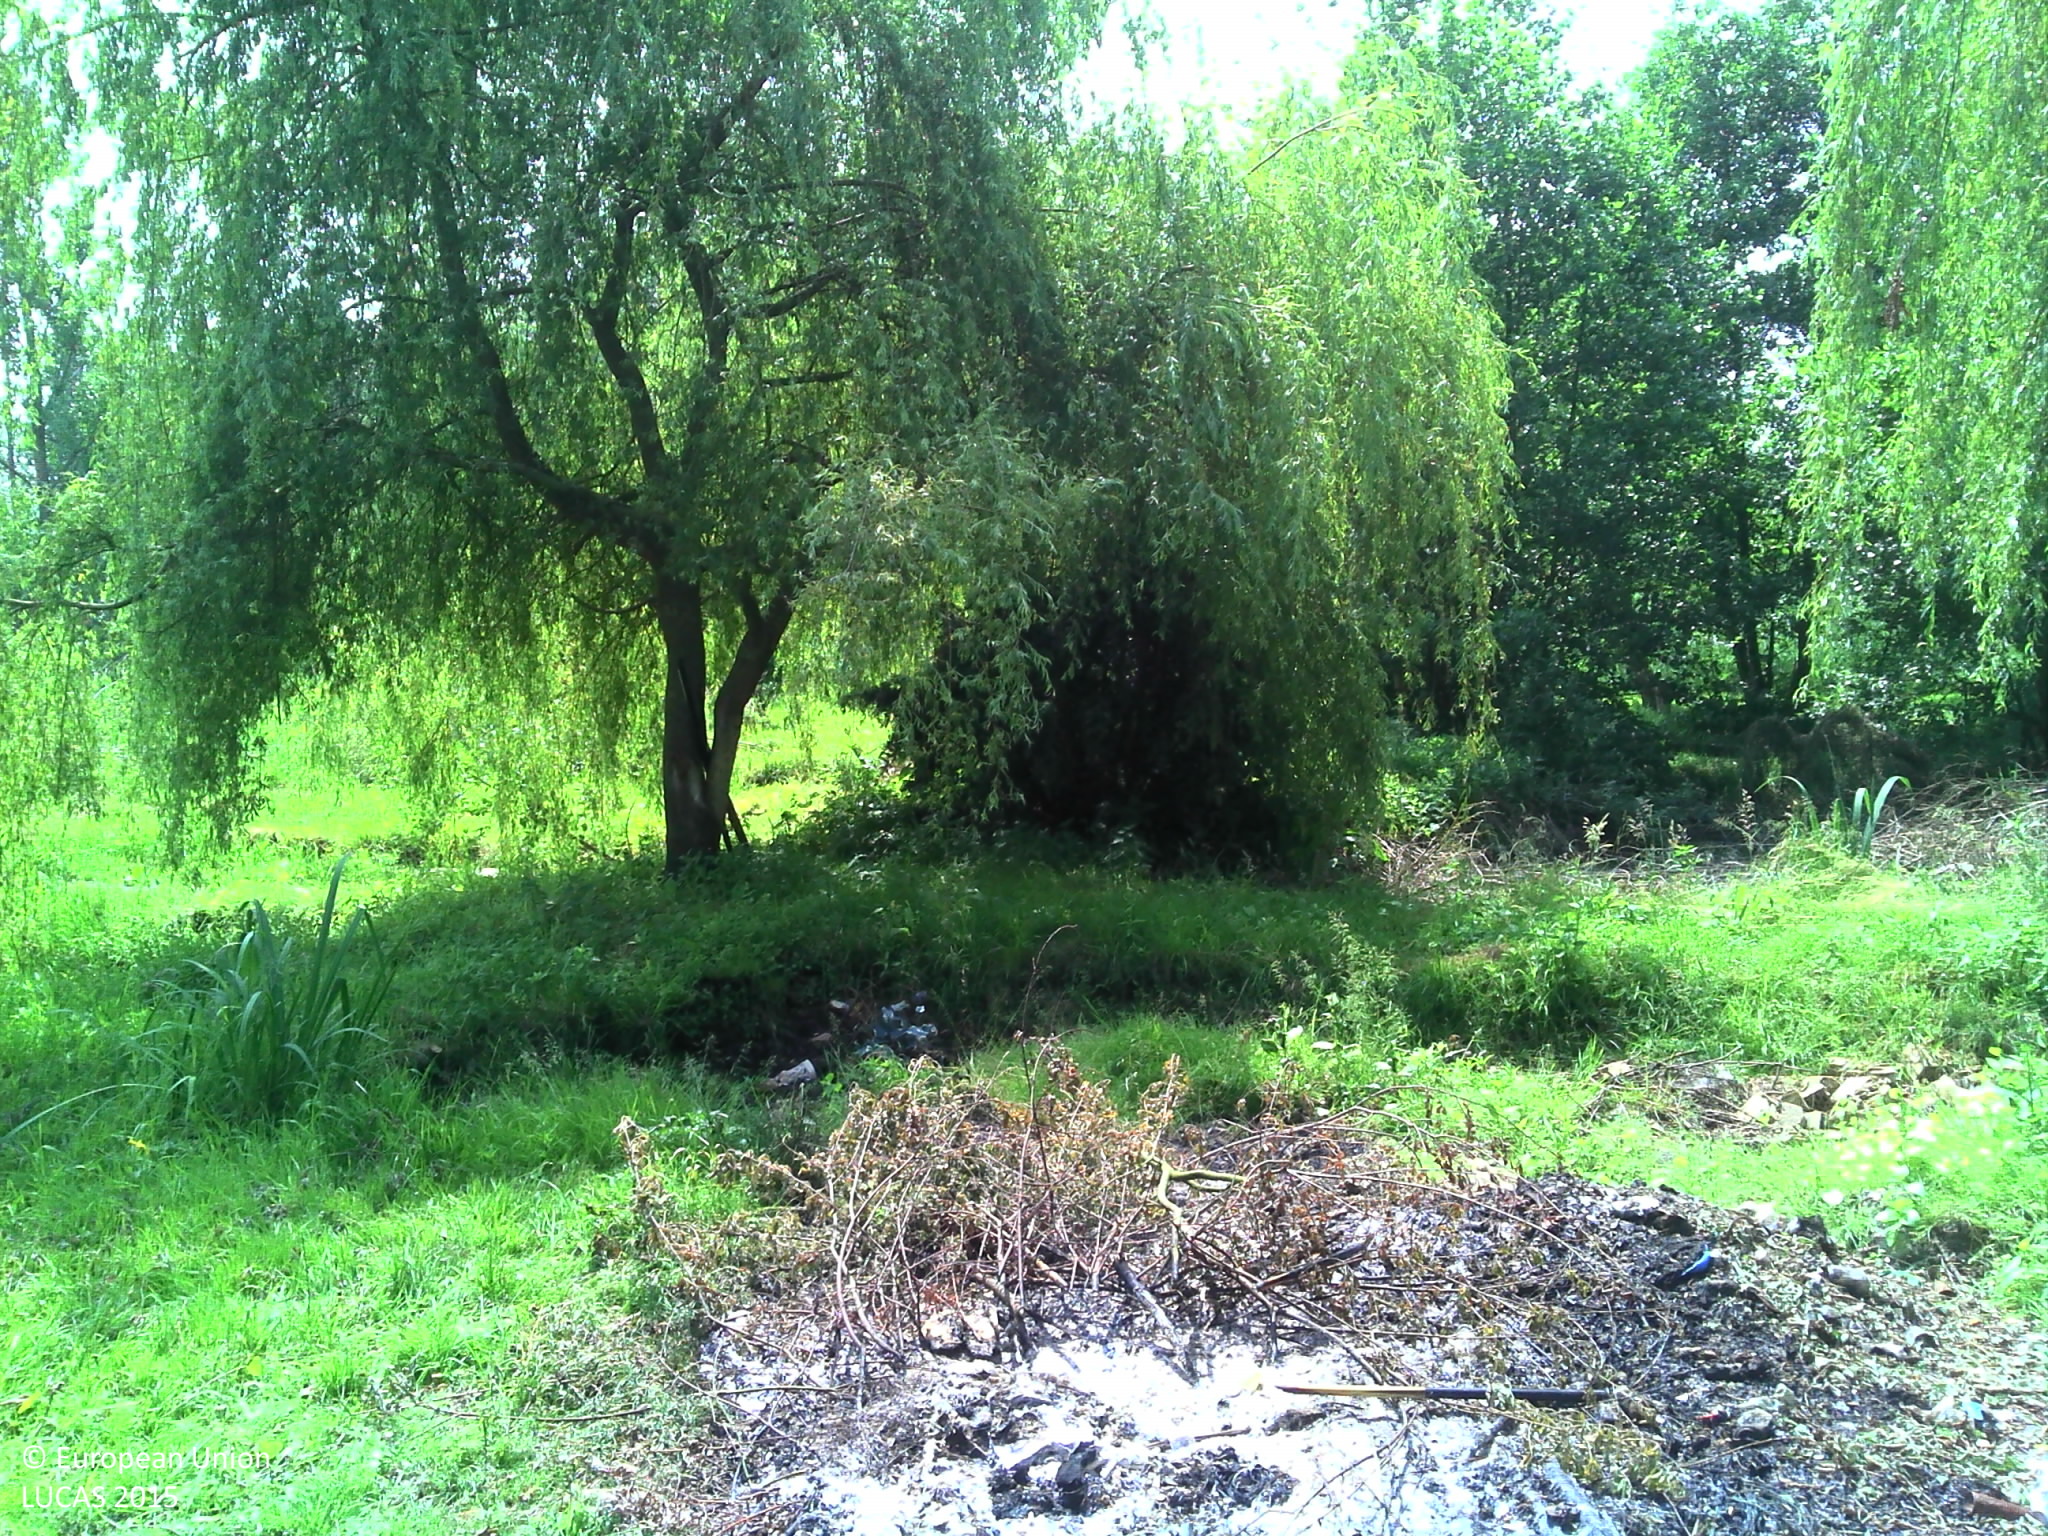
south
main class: Grassland
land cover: Grassland with sparse tree/shrub cover
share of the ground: > 75 %
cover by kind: herbaceous plants 95 %, broadleaved forest trees 5 %
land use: Residential
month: June
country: BE
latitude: 50.4623
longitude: 3.7245
